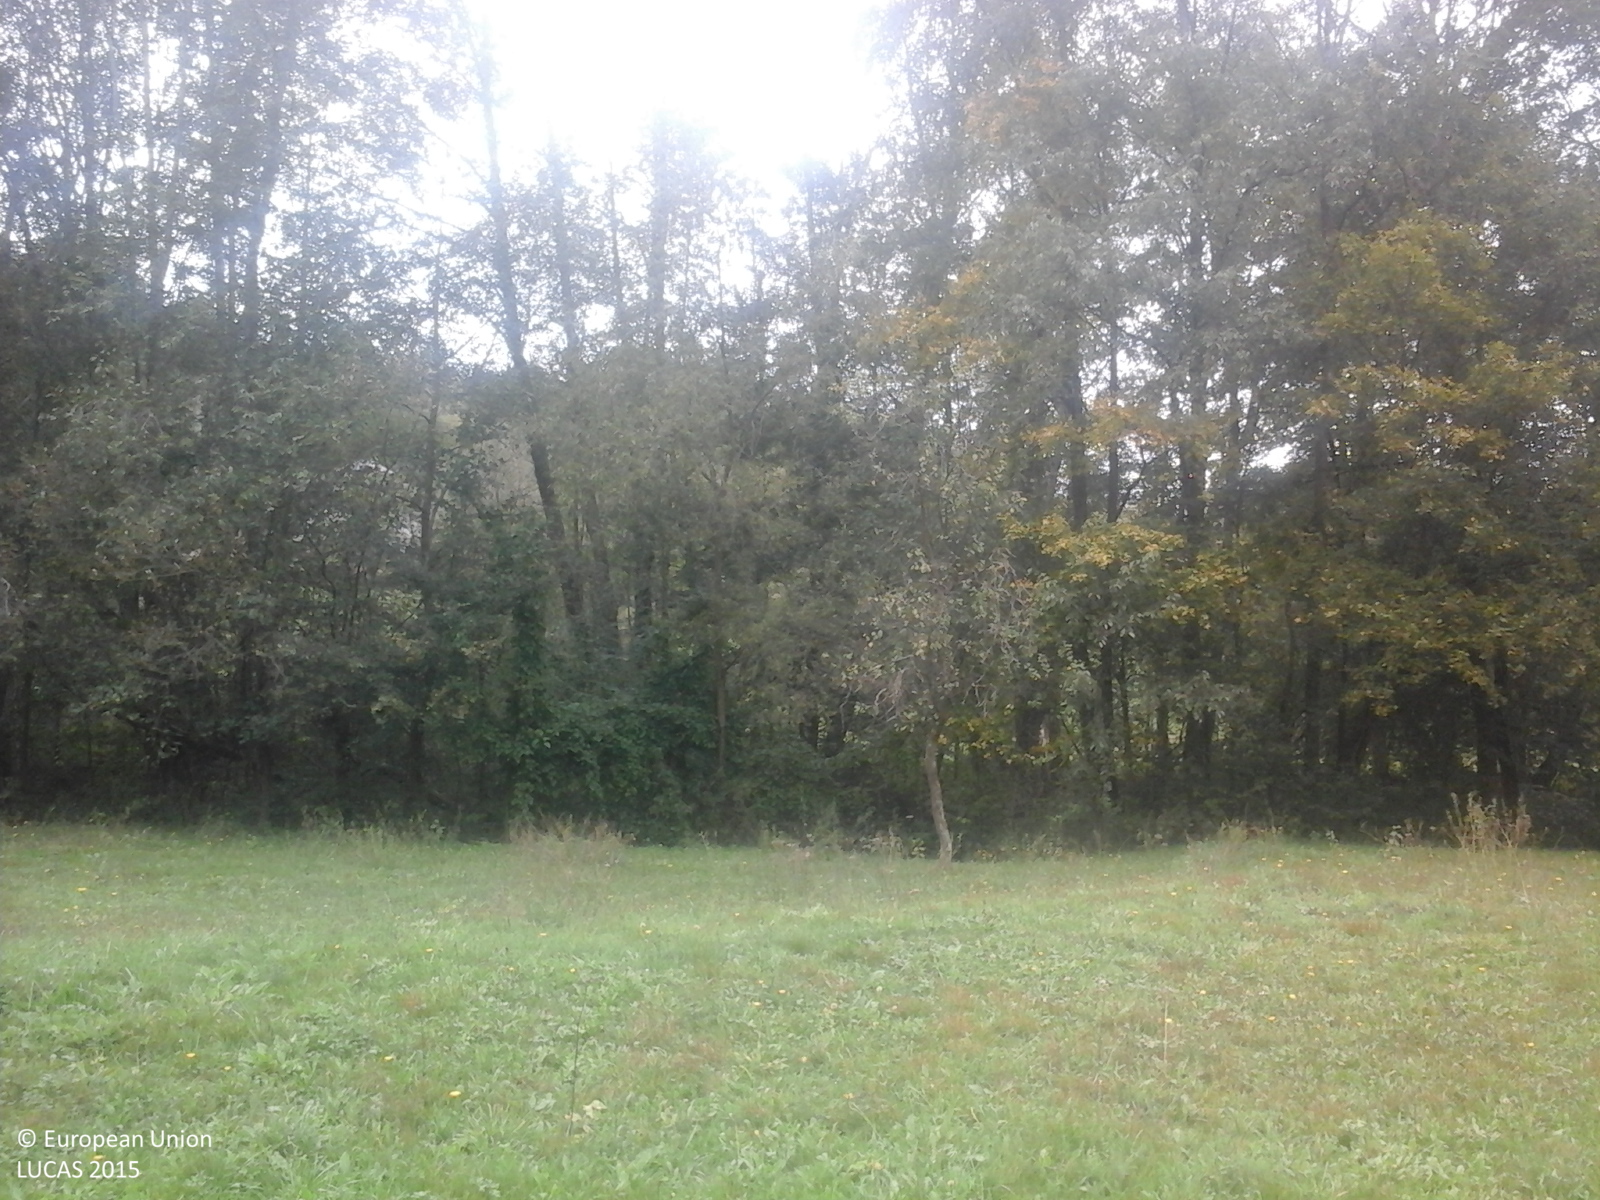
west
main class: Grassland
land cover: Grassland without tree/shrub cover
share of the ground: > 75 %
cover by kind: herbaceous plants 100 %
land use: Agriculture (excluding fallow land and kitchen gardens)
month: October
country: RO
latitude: 46.3530
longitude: 23.1734
